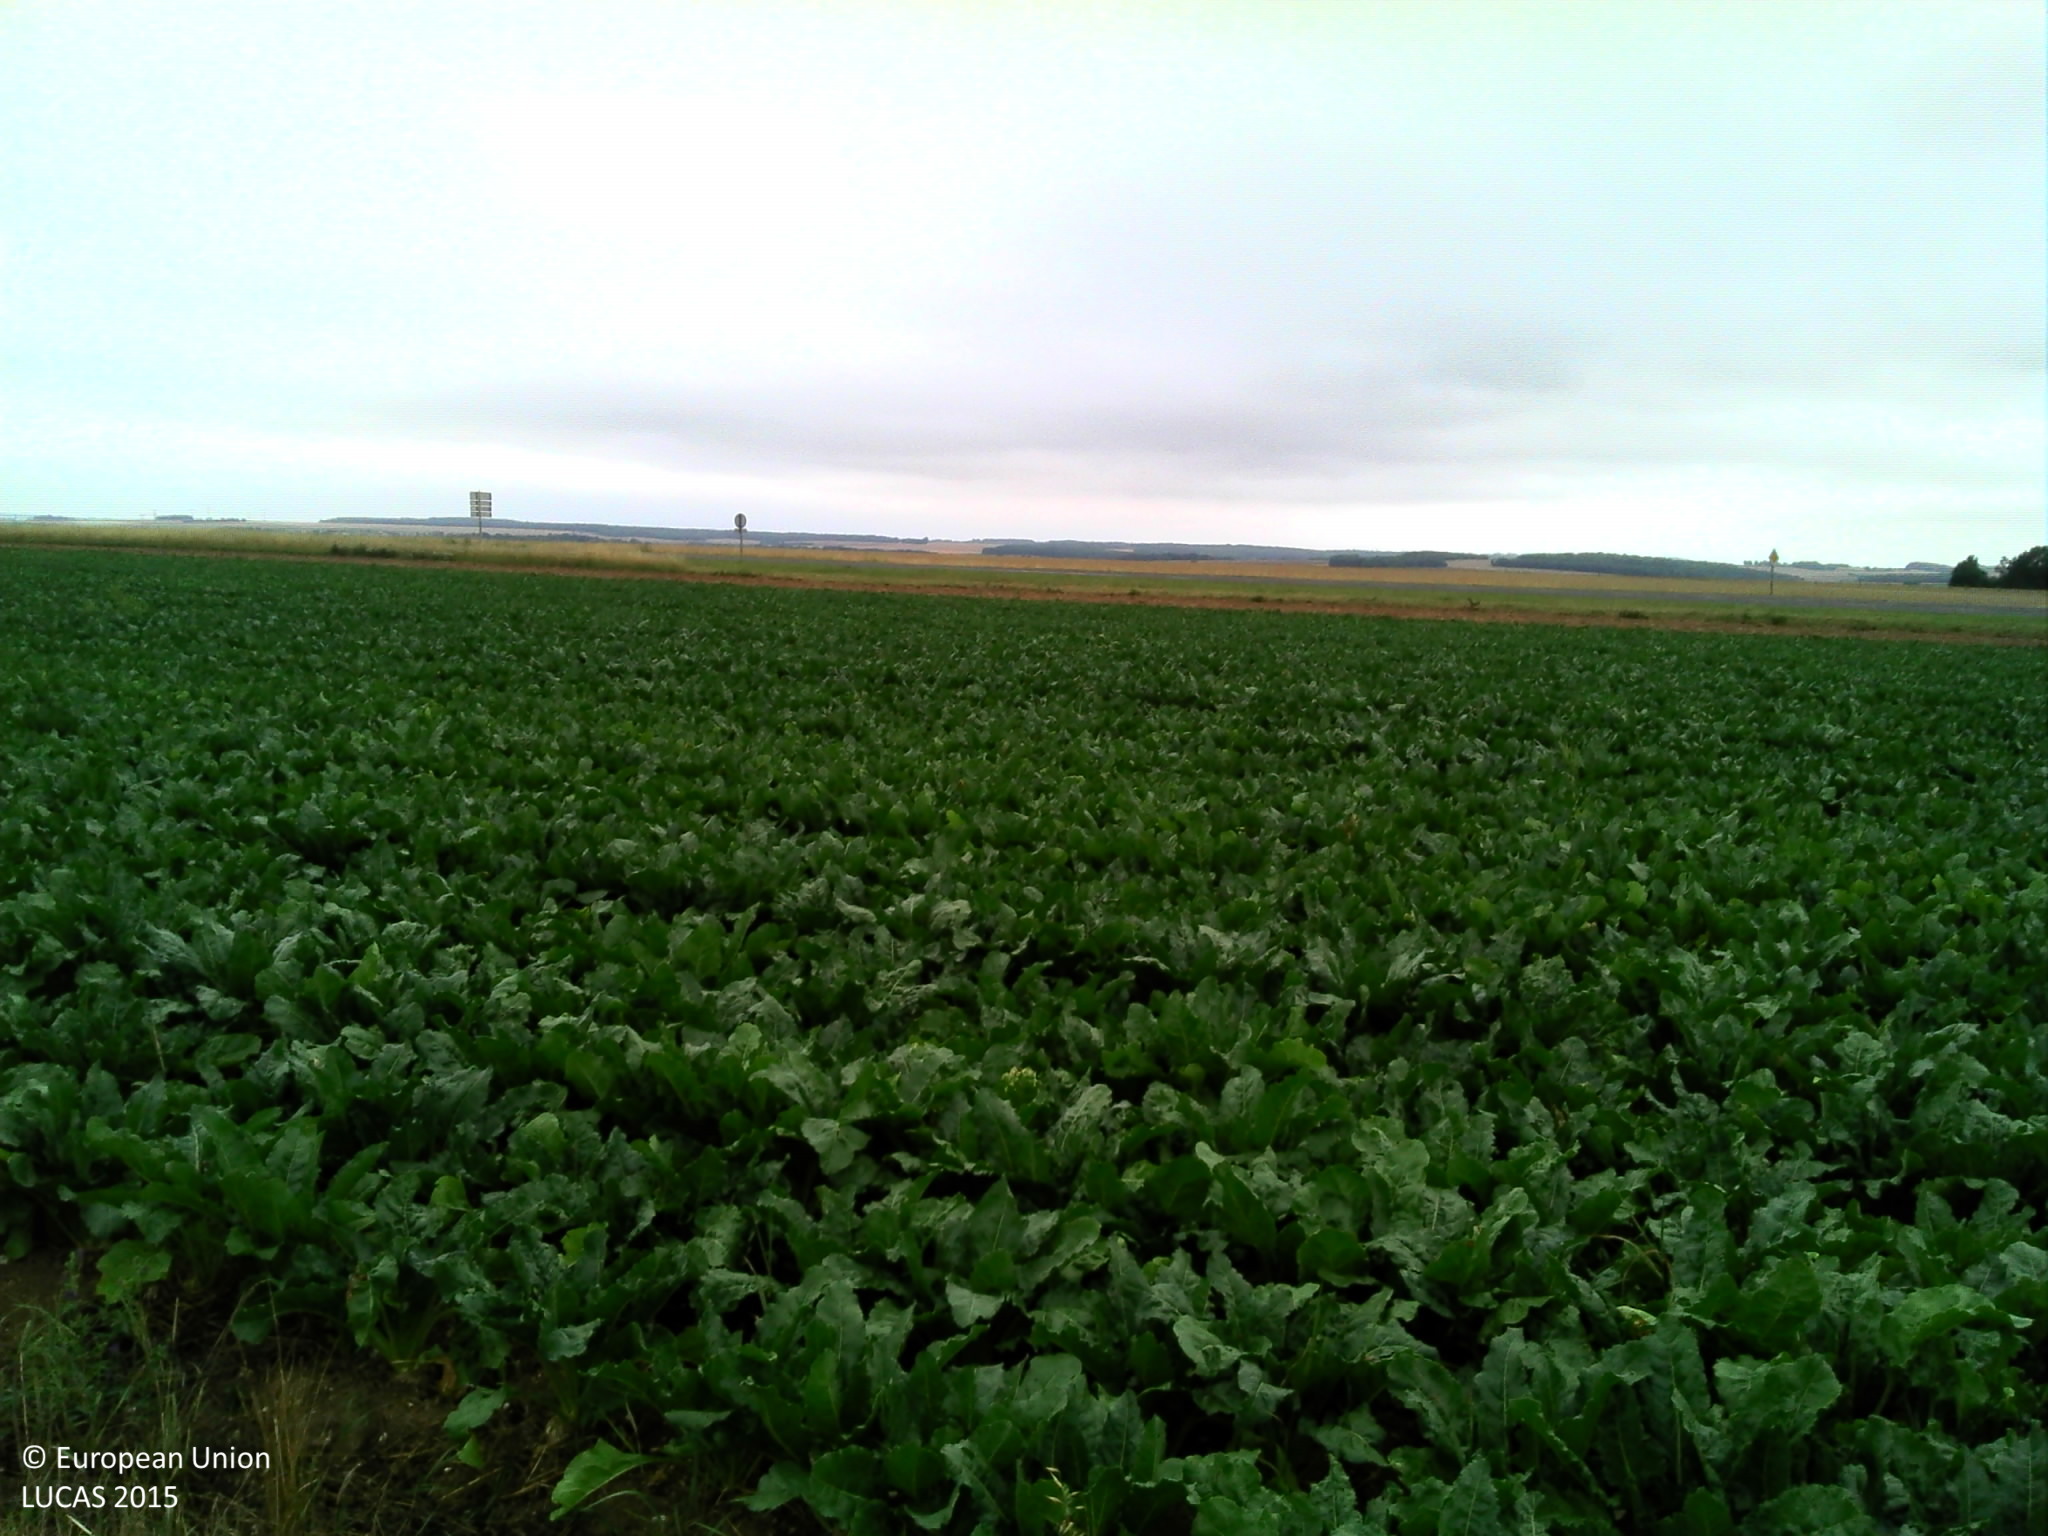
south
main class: Cropland
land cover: Lucerne
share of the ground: > 75 %
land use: Agriculture (excluding fallow land and kitchen gardens)
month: July
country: FR
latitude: 49.9685
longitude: 2.1642
